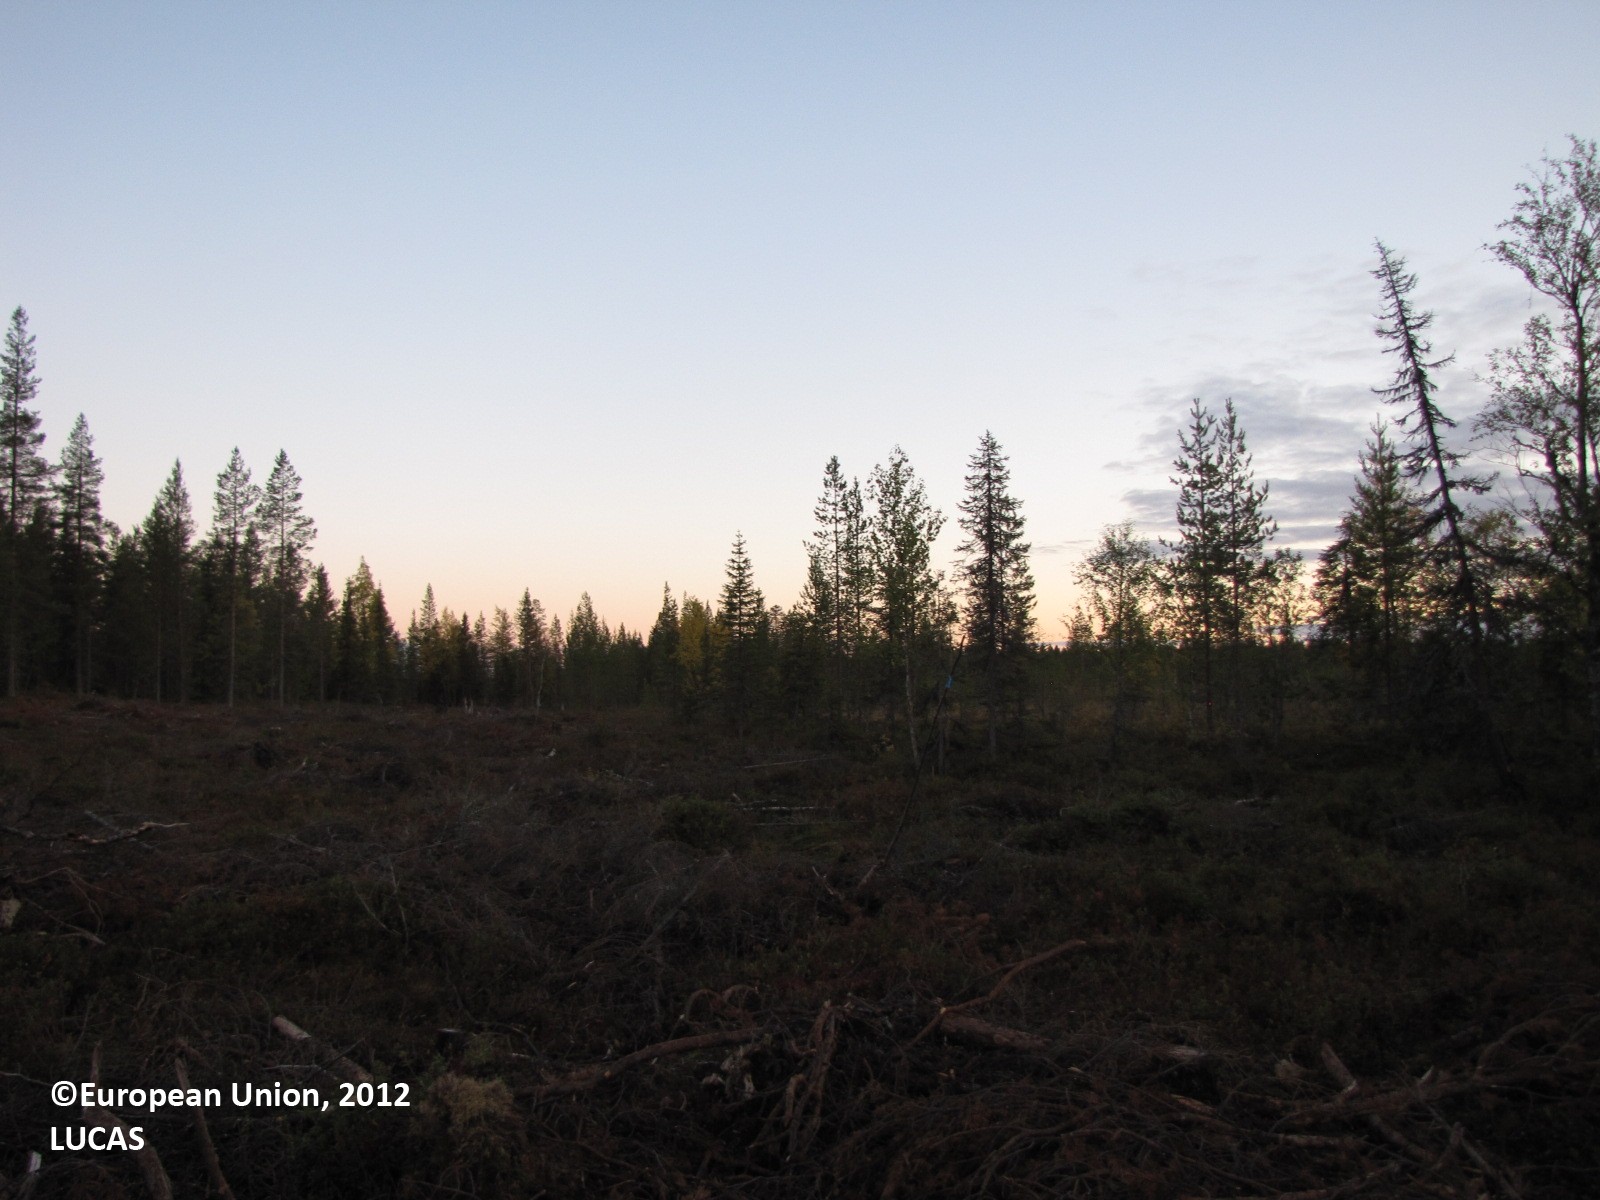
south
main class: Shrubland
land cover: Shrubland without tree cover
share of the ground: 10 - 25 %
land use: Forestry
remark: Clear cut
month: September
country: FI
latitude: 67.3745
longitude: 25.2567
